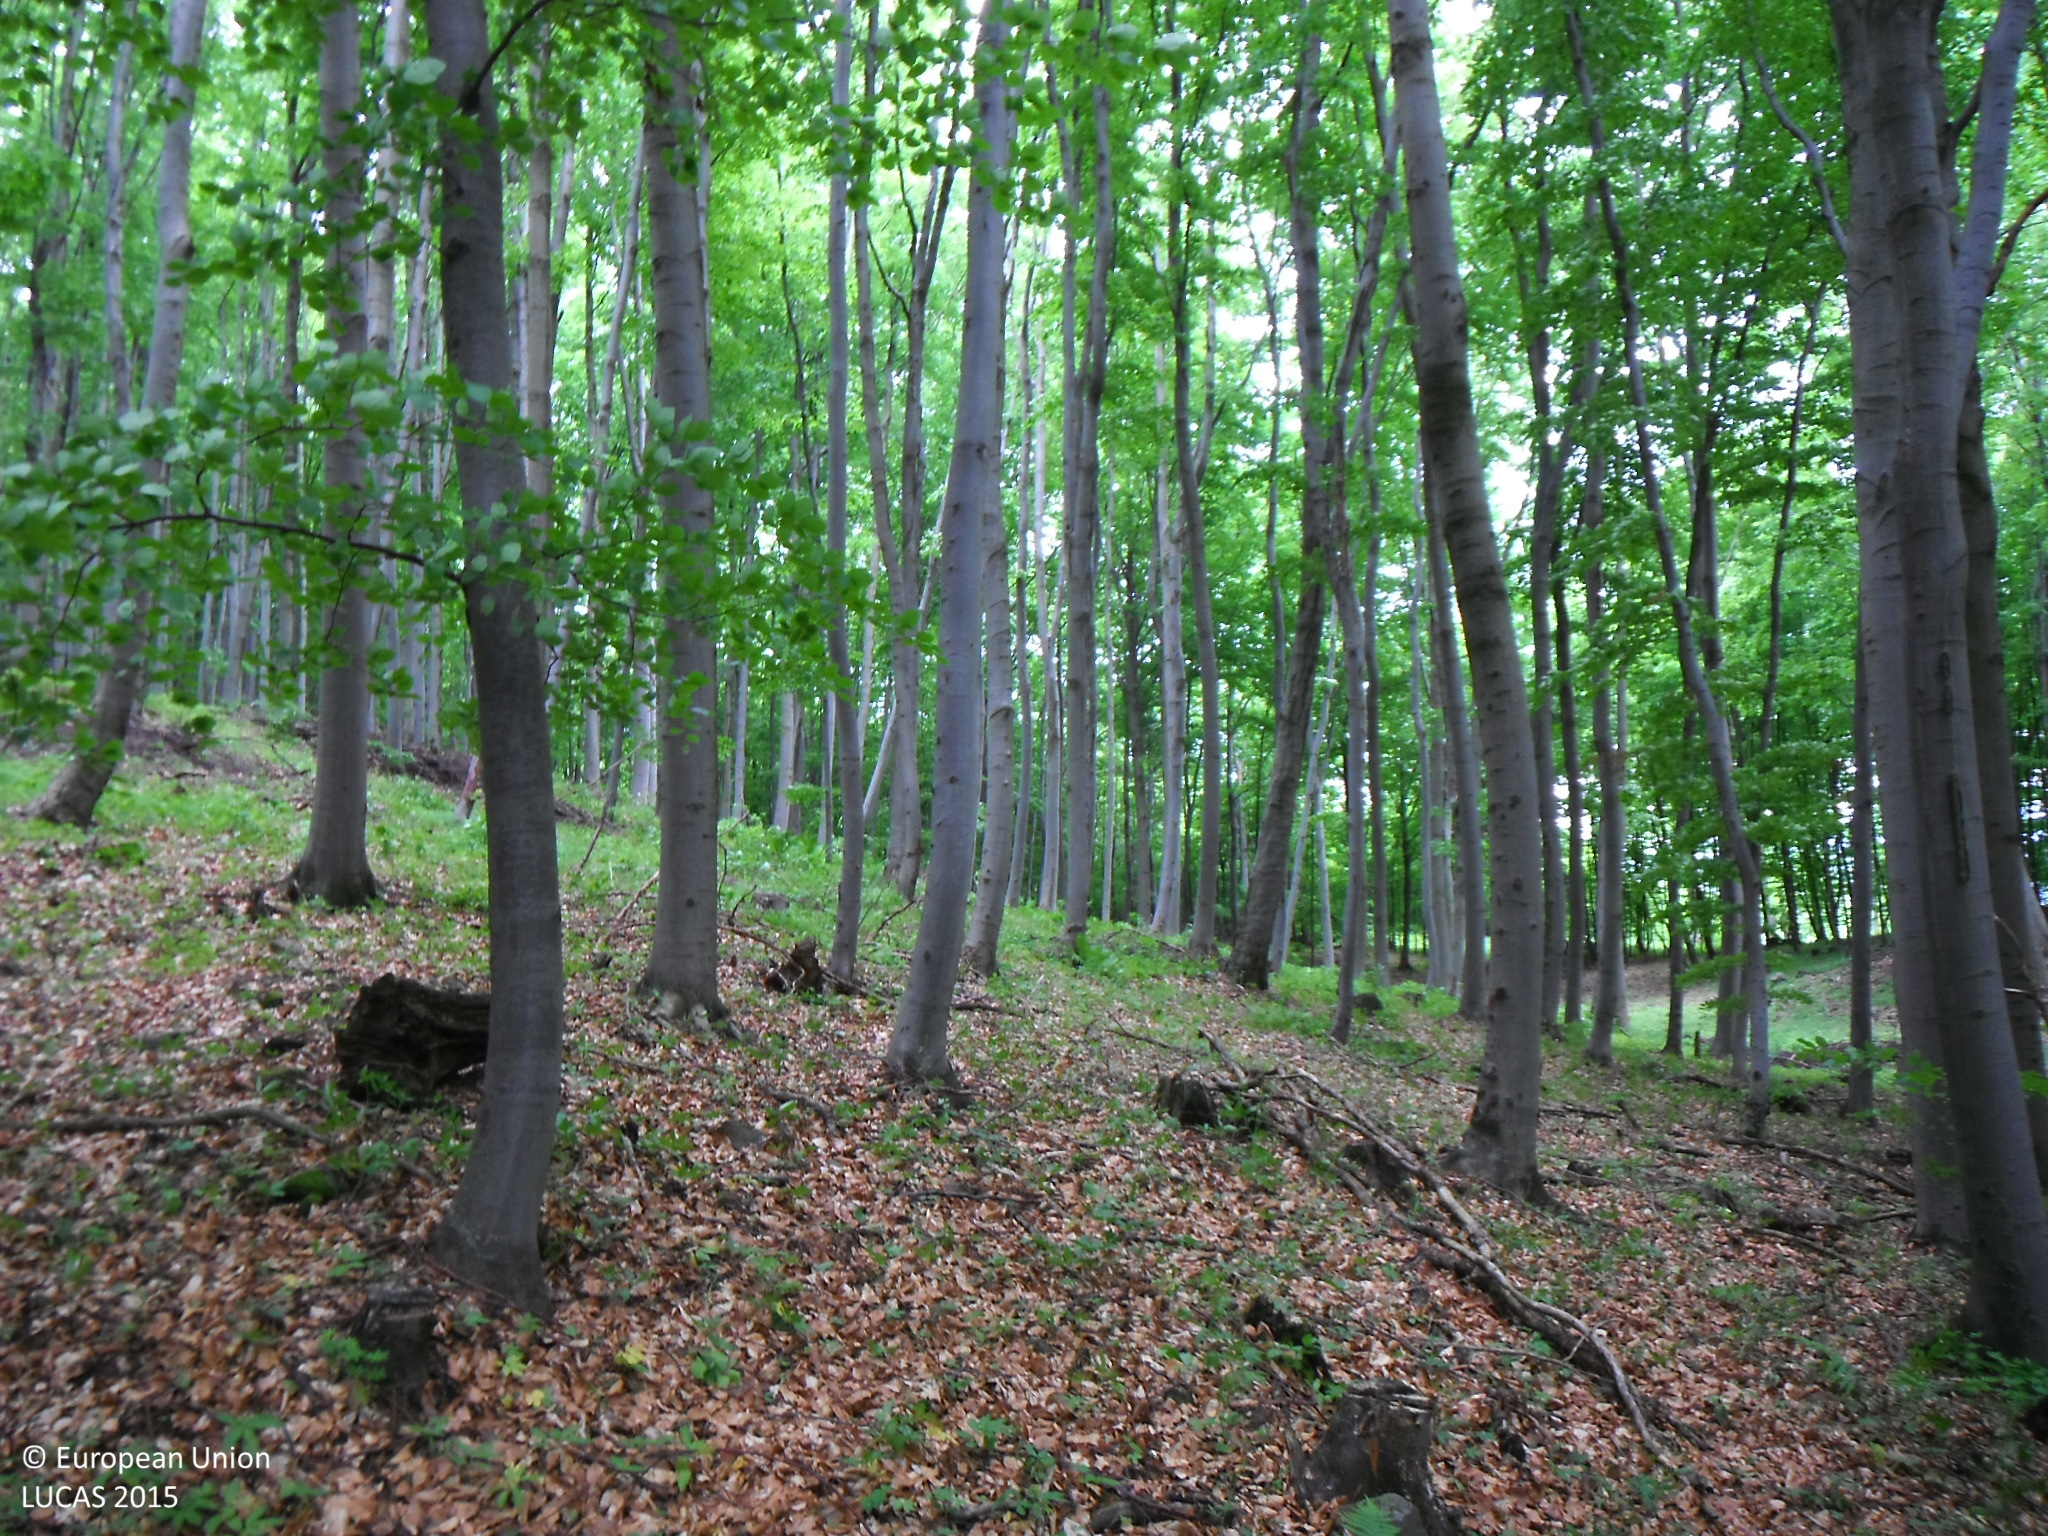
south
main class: Woodland
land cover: Broadleaved woodland
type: beech forest
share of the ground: > 75 %
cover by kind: broadleaved forest trees 100 %
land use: Forestry
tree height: > 5 m
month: May
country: SK
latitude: 48.9801
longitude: 21.3459
